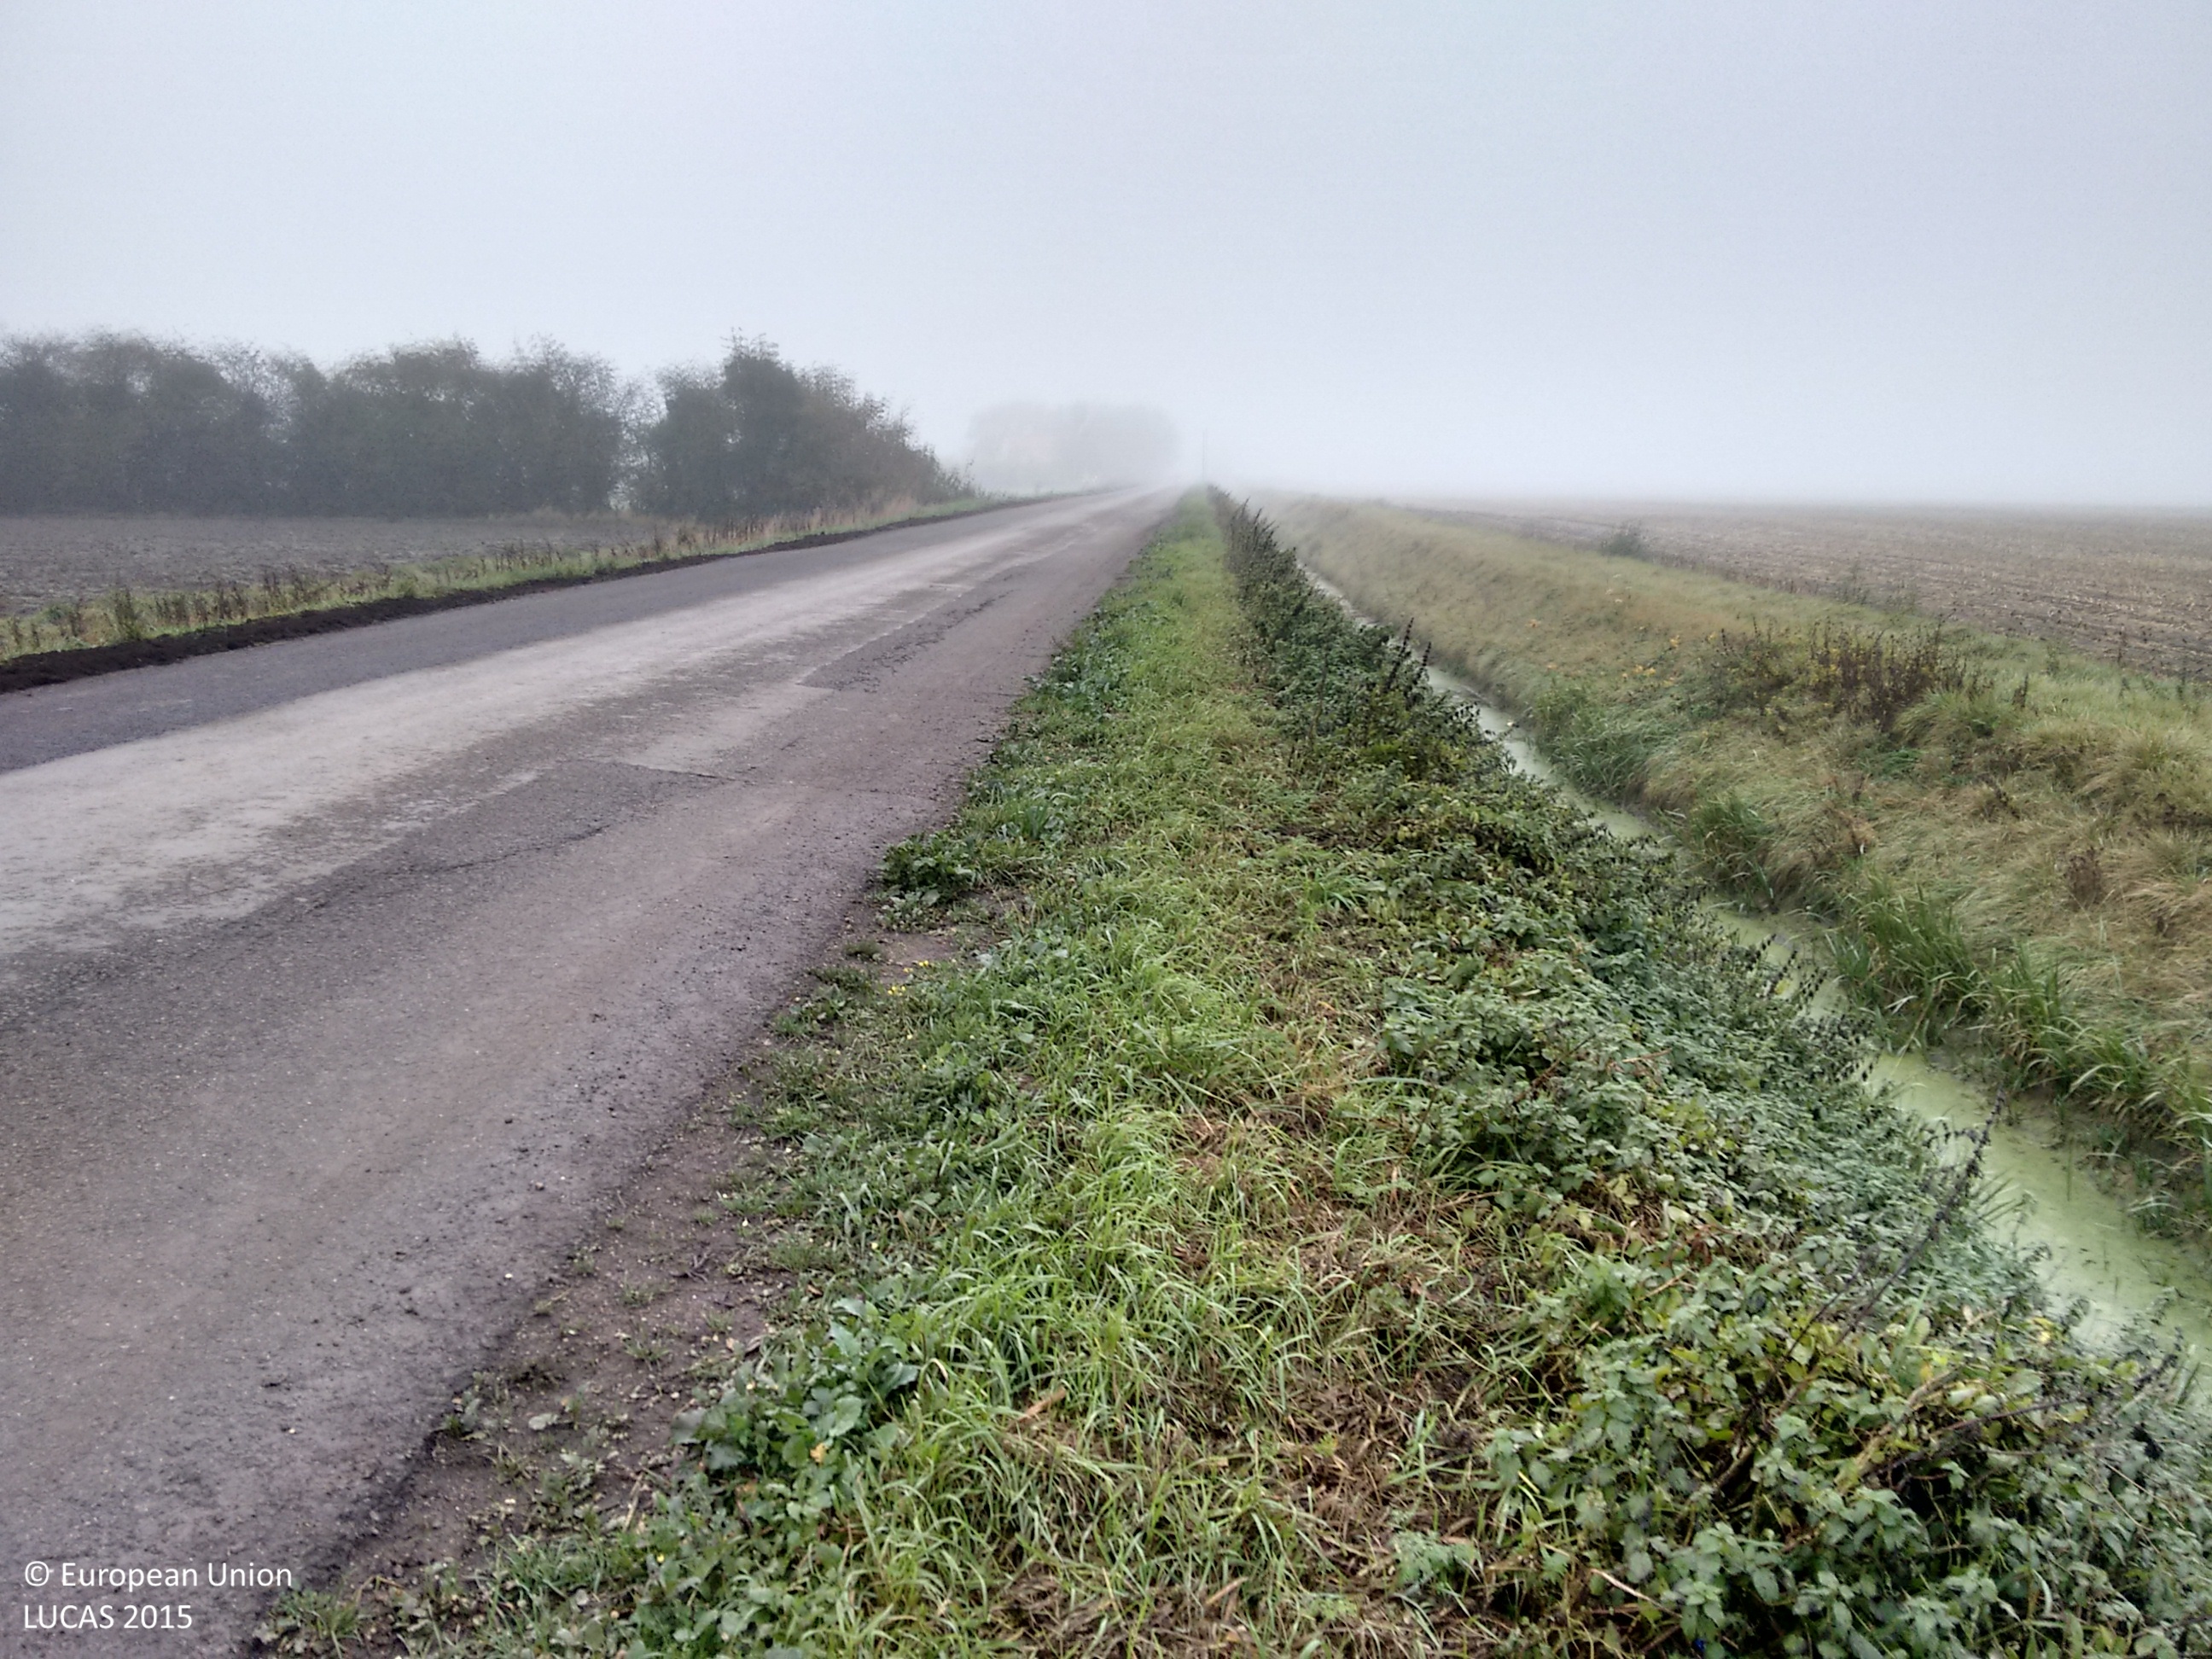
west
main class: Cropland
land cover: Maize
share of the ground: > 75 %
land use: Agriculture (excluding fallow land and kitchen gardens)
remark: Harvested field
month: November
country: GB
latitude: 53.0939
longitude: -0.0225
